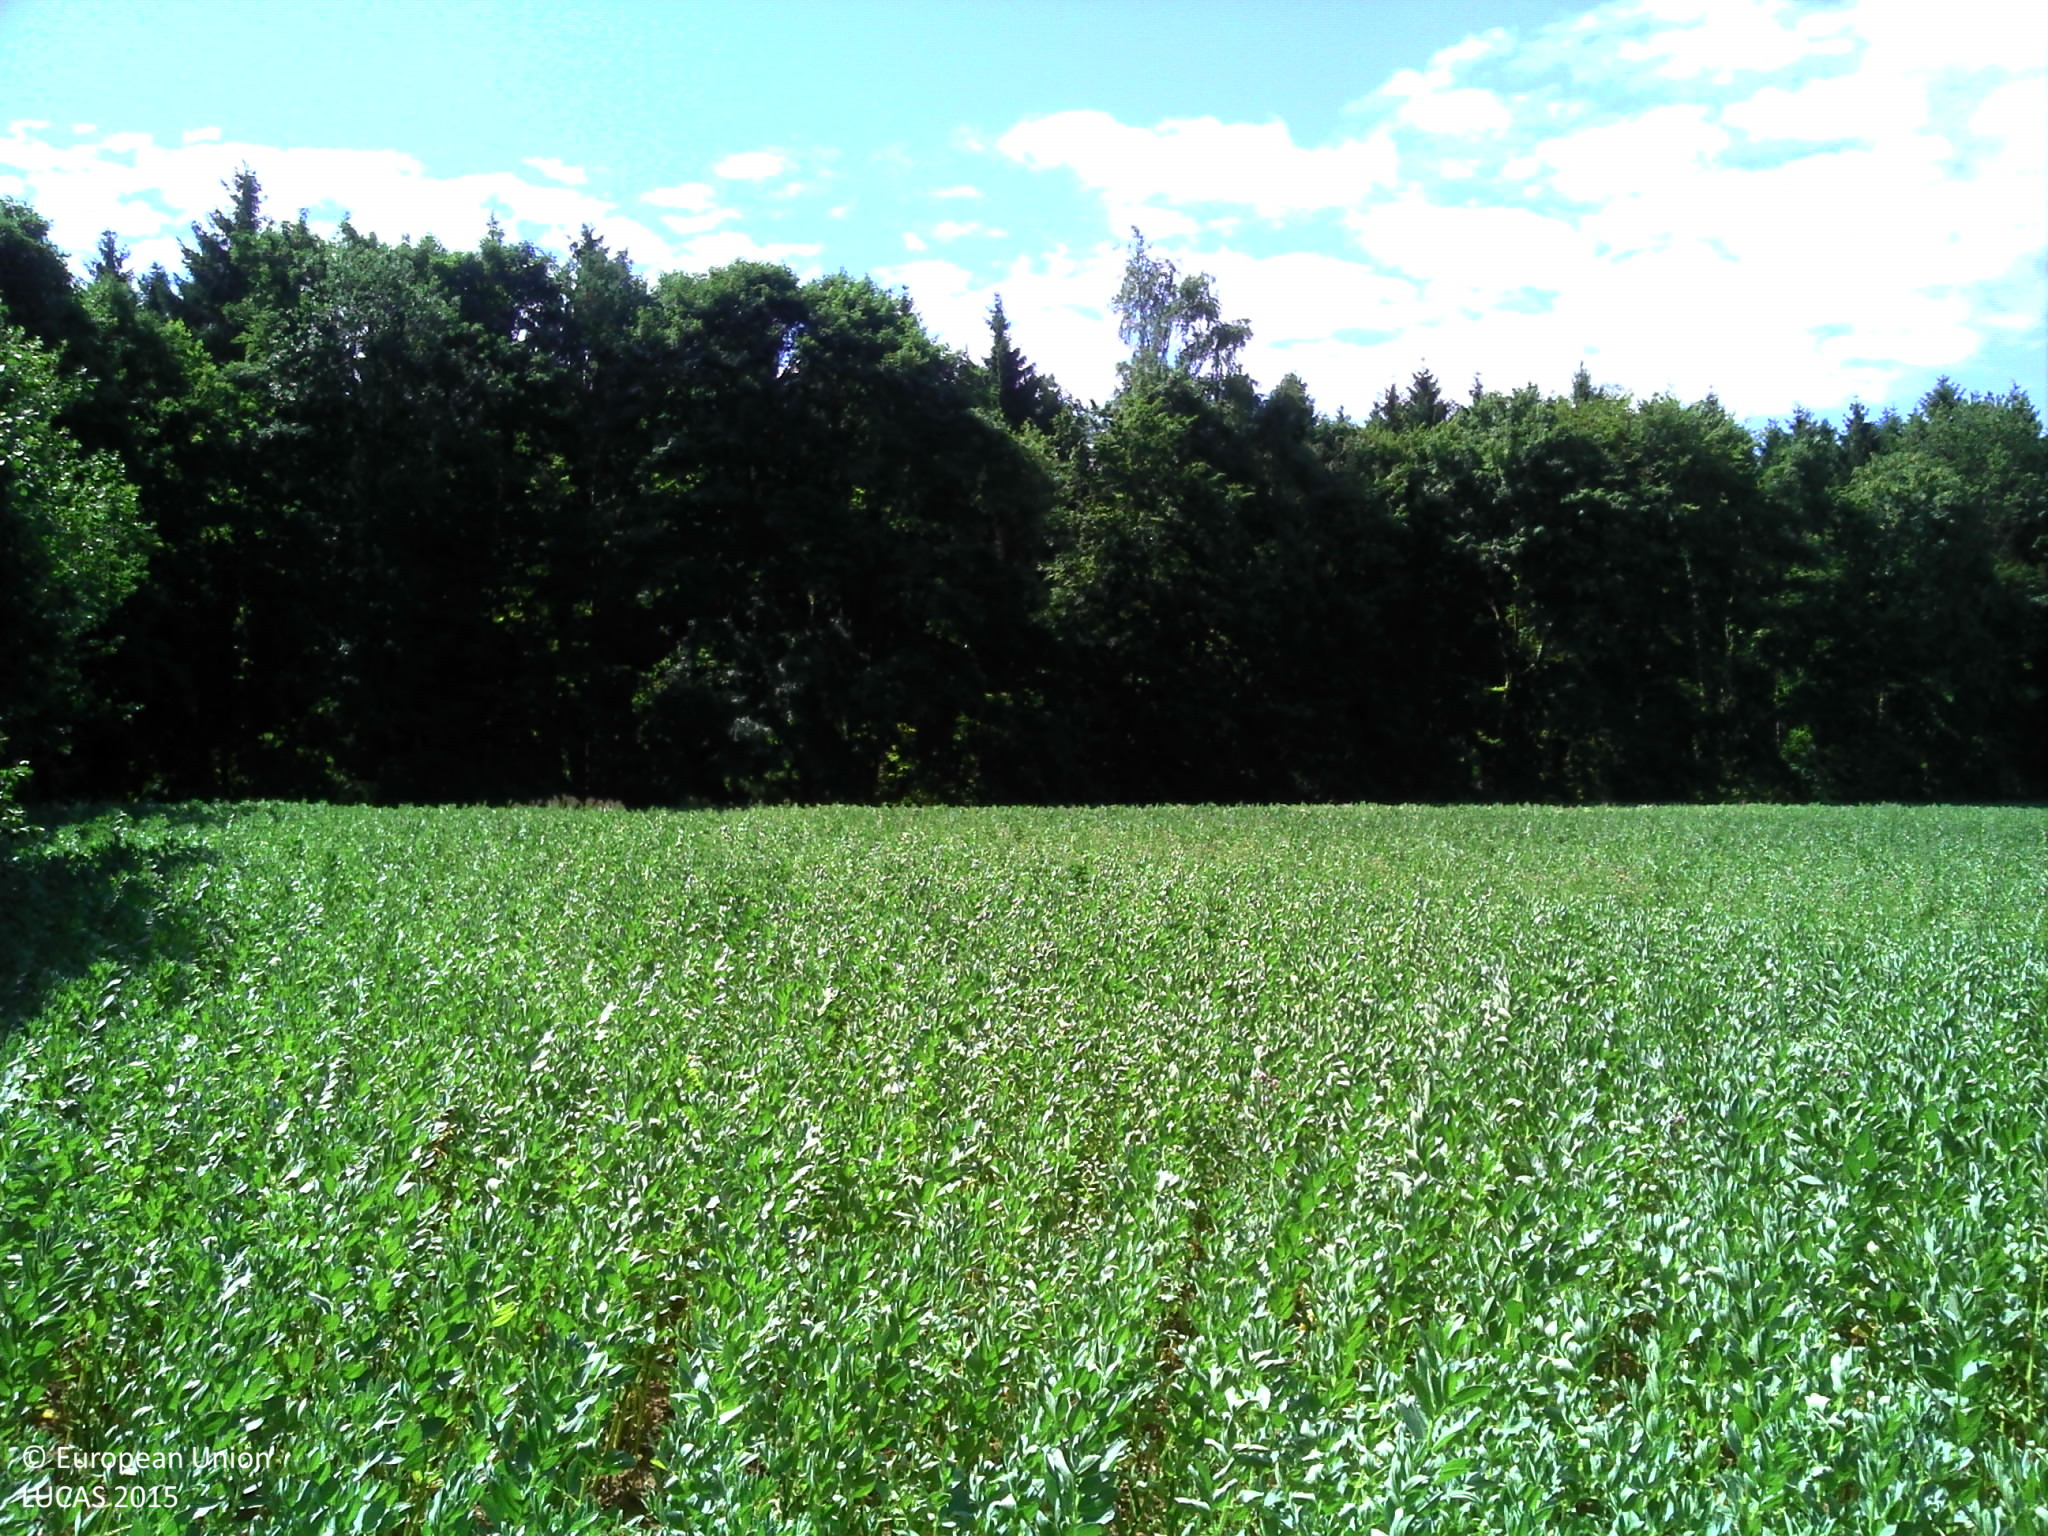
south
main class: Cropland
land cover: Dry pulses
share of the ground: > 75 %
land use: Agriculture (excluding fallow land and kitchen gardens)
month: July
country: FR
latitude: 49.4623
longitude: 5.9014
